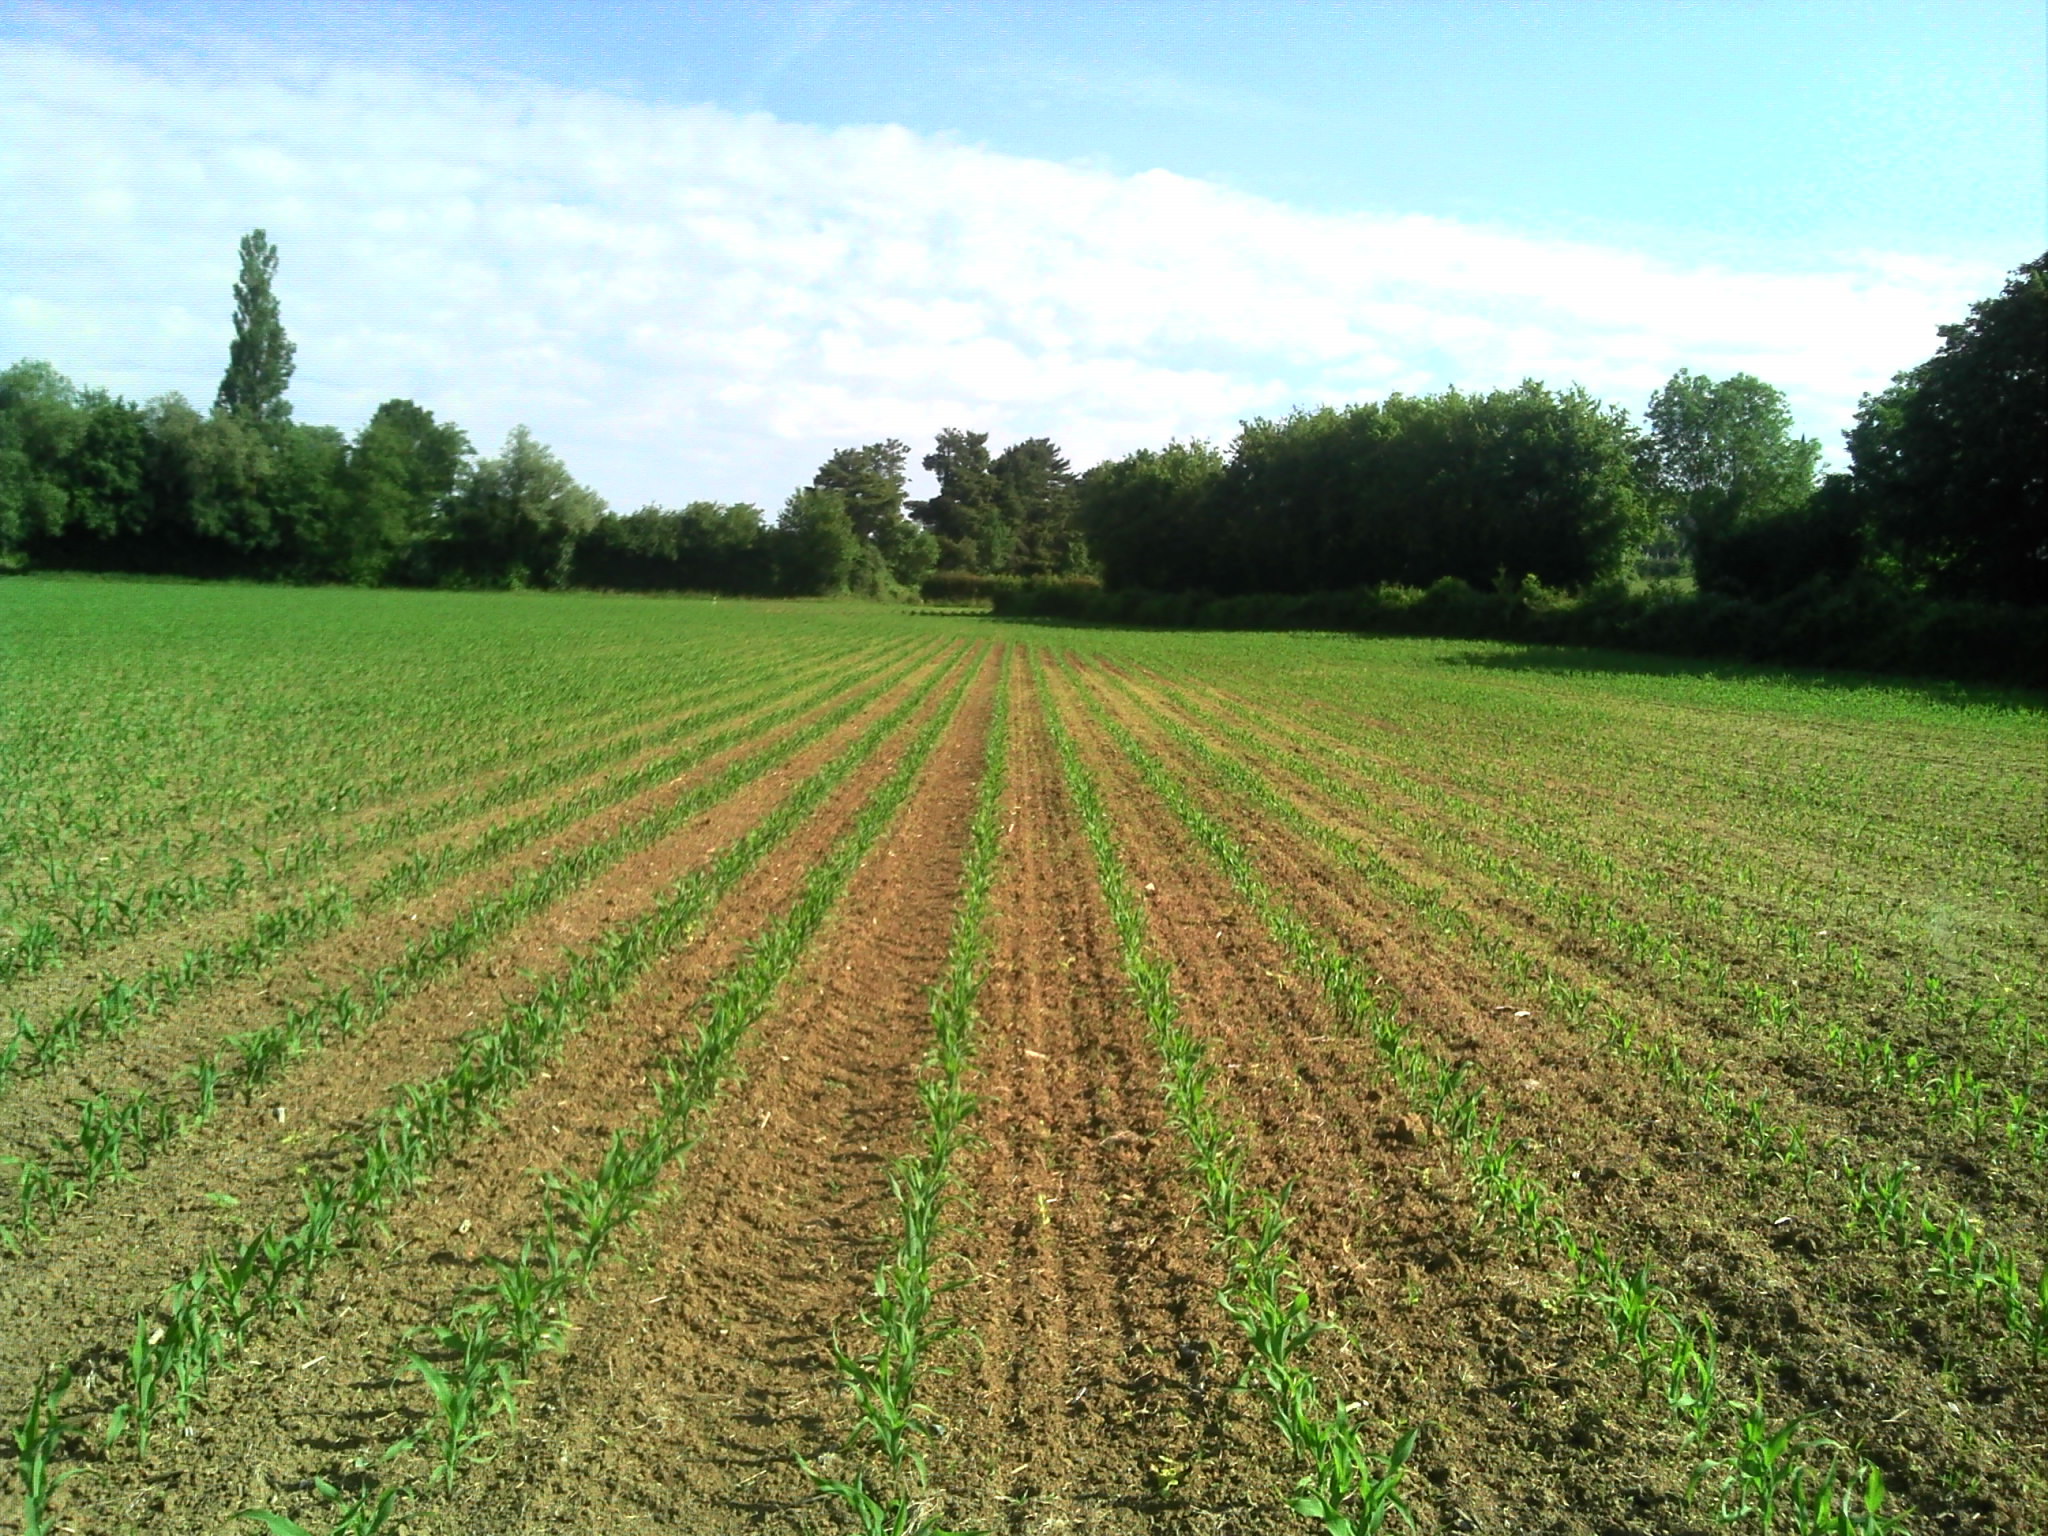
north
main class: Cropland
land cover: Maize
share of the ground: 10 - 25 %
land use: Agriculture (excluding fallow land and kitchen gardens)
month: May
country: FR
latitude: 46.6181
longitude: 5.1050
